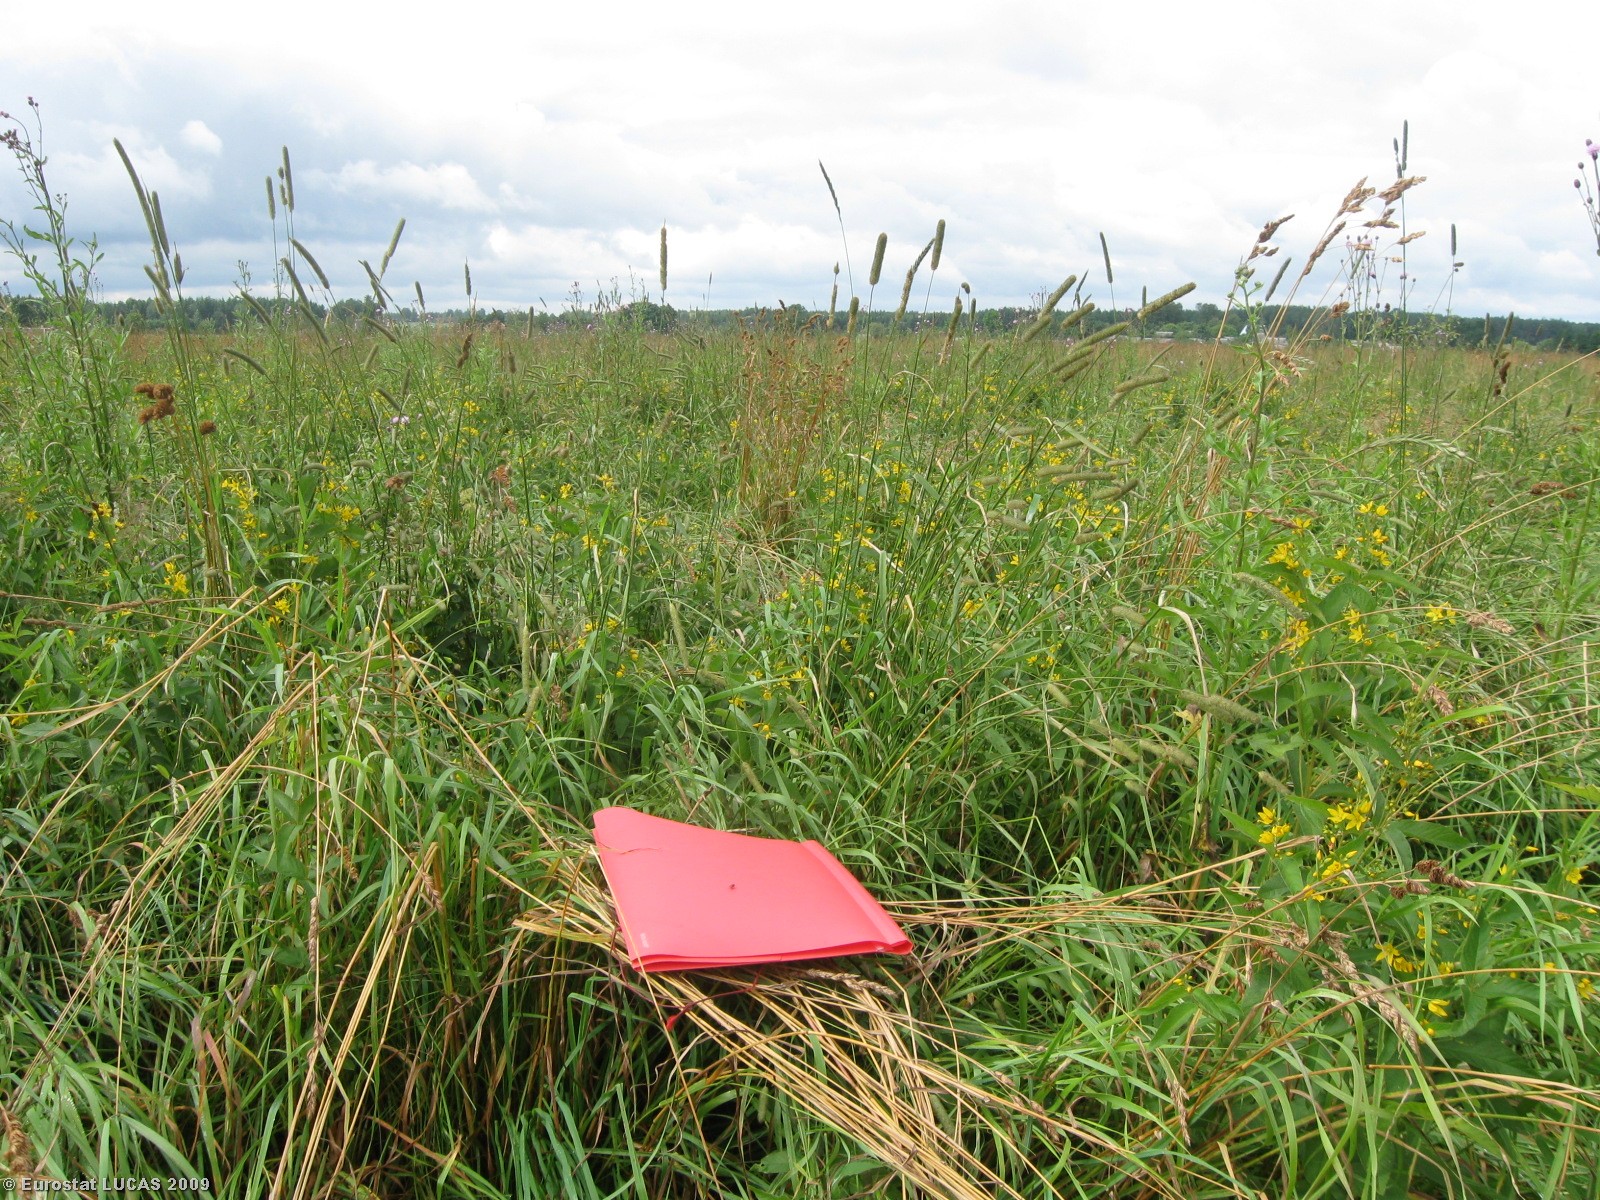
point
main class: Grassland
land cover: Spontaneously vegetated surfaces
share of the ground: > 75 %
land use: Fallow land
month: July
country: LT
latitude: 54.4307
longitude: 25.4965
